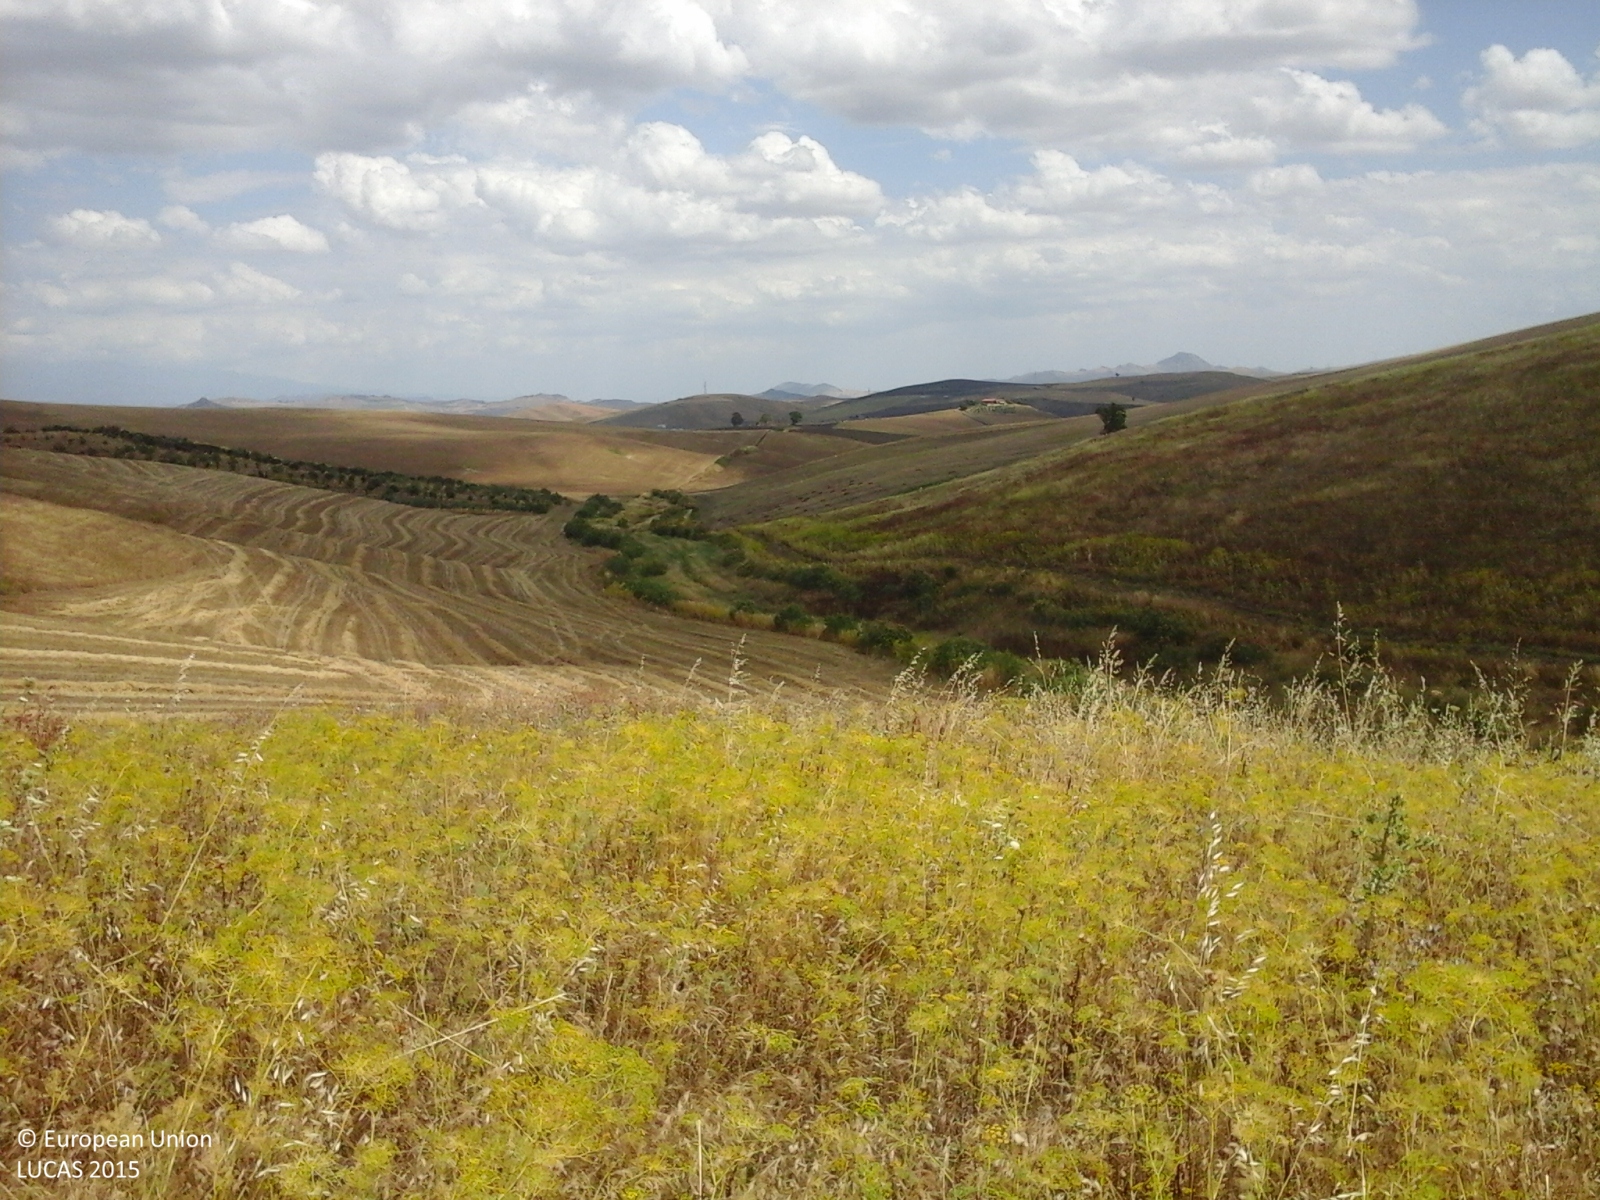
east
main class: Grassland
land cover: Grassland without tree/shrub cover
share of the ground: > 75 %
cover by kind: herbaceous plants 75 %, unconsolidated bare surface 25 %
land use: Agriculture (excluding fallow land and kitchen gardens)
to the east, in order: Grassland without tree/shrub cover; Durum wheat; Grass margins; Abandoned hedges; Grass margins; Ditches and canals; Grassland without tree/shrub cover
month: June
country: IT
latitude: 37.5540
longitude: 14.4163
